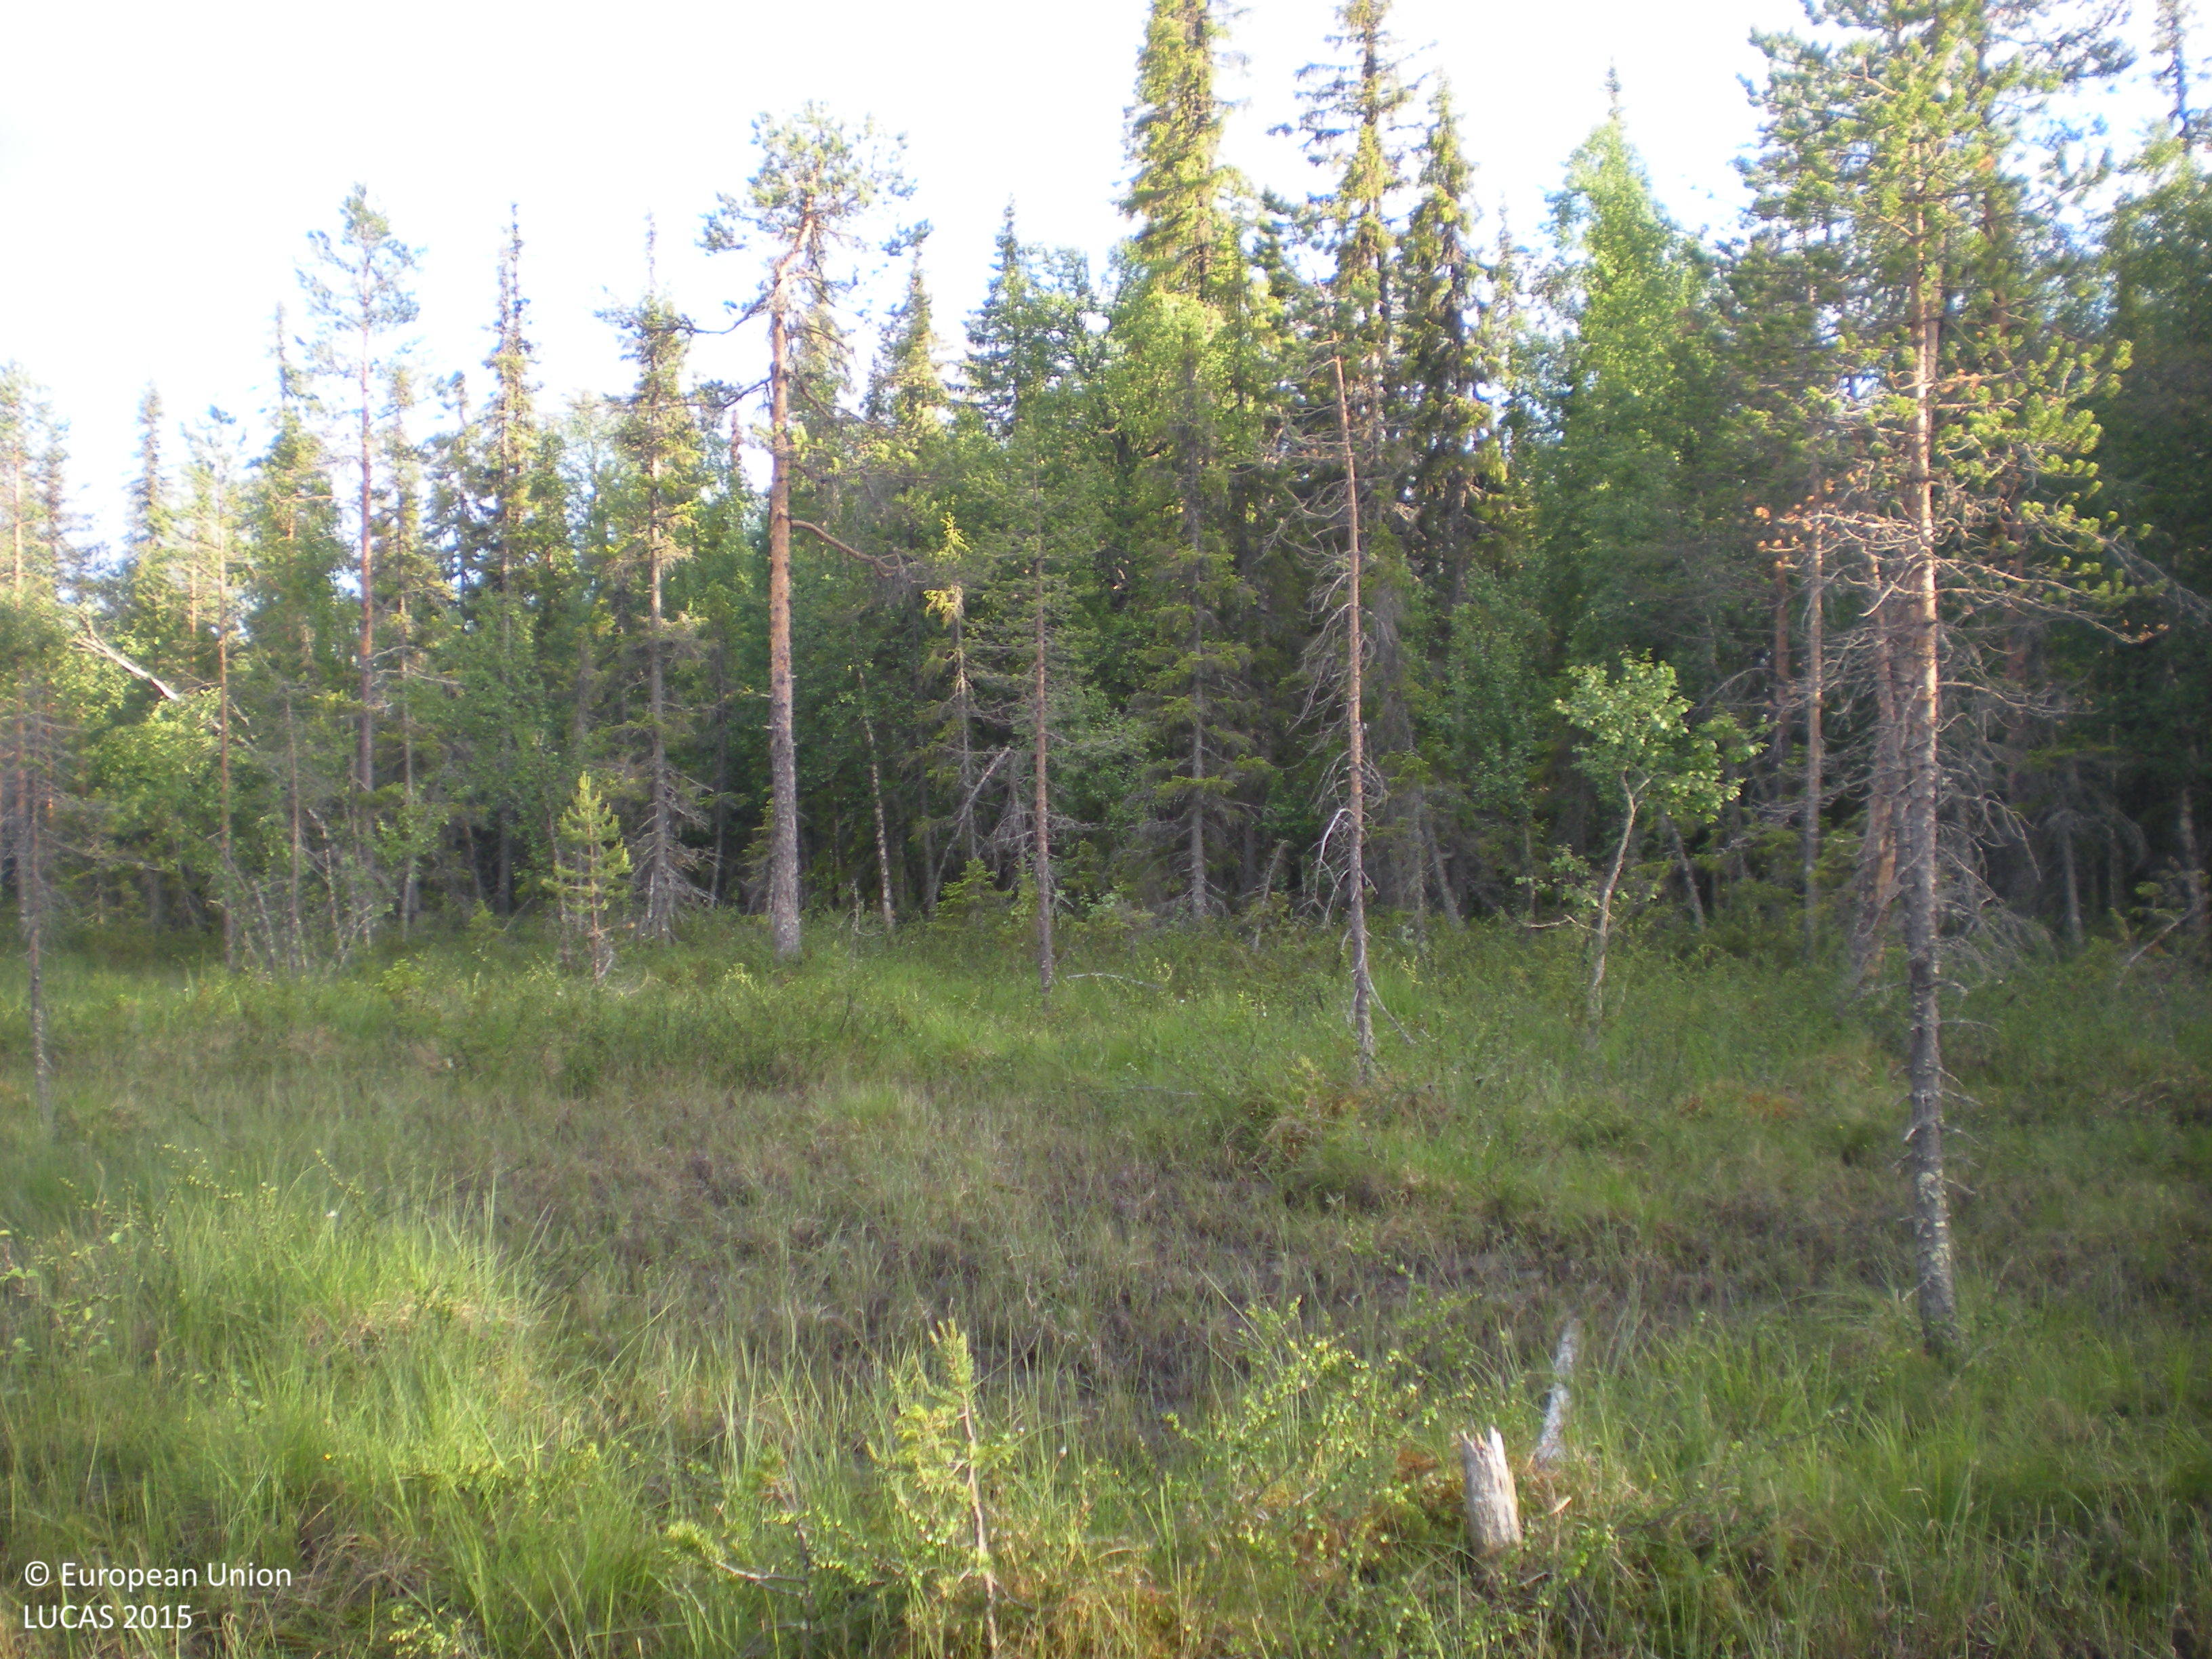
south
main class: Woodland
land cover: Pine dominated mixed woodland
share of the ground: < 10 %
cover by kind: lichens and mosses 55 %, herbaceous plants 25 %, coniferous forest trees 10 %, broadleaved forest trees 5 %, shrubs 5 %
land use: Semi-natural and natural areas not in use
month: July
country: SE
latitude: 65.4816
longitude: 18.1016
